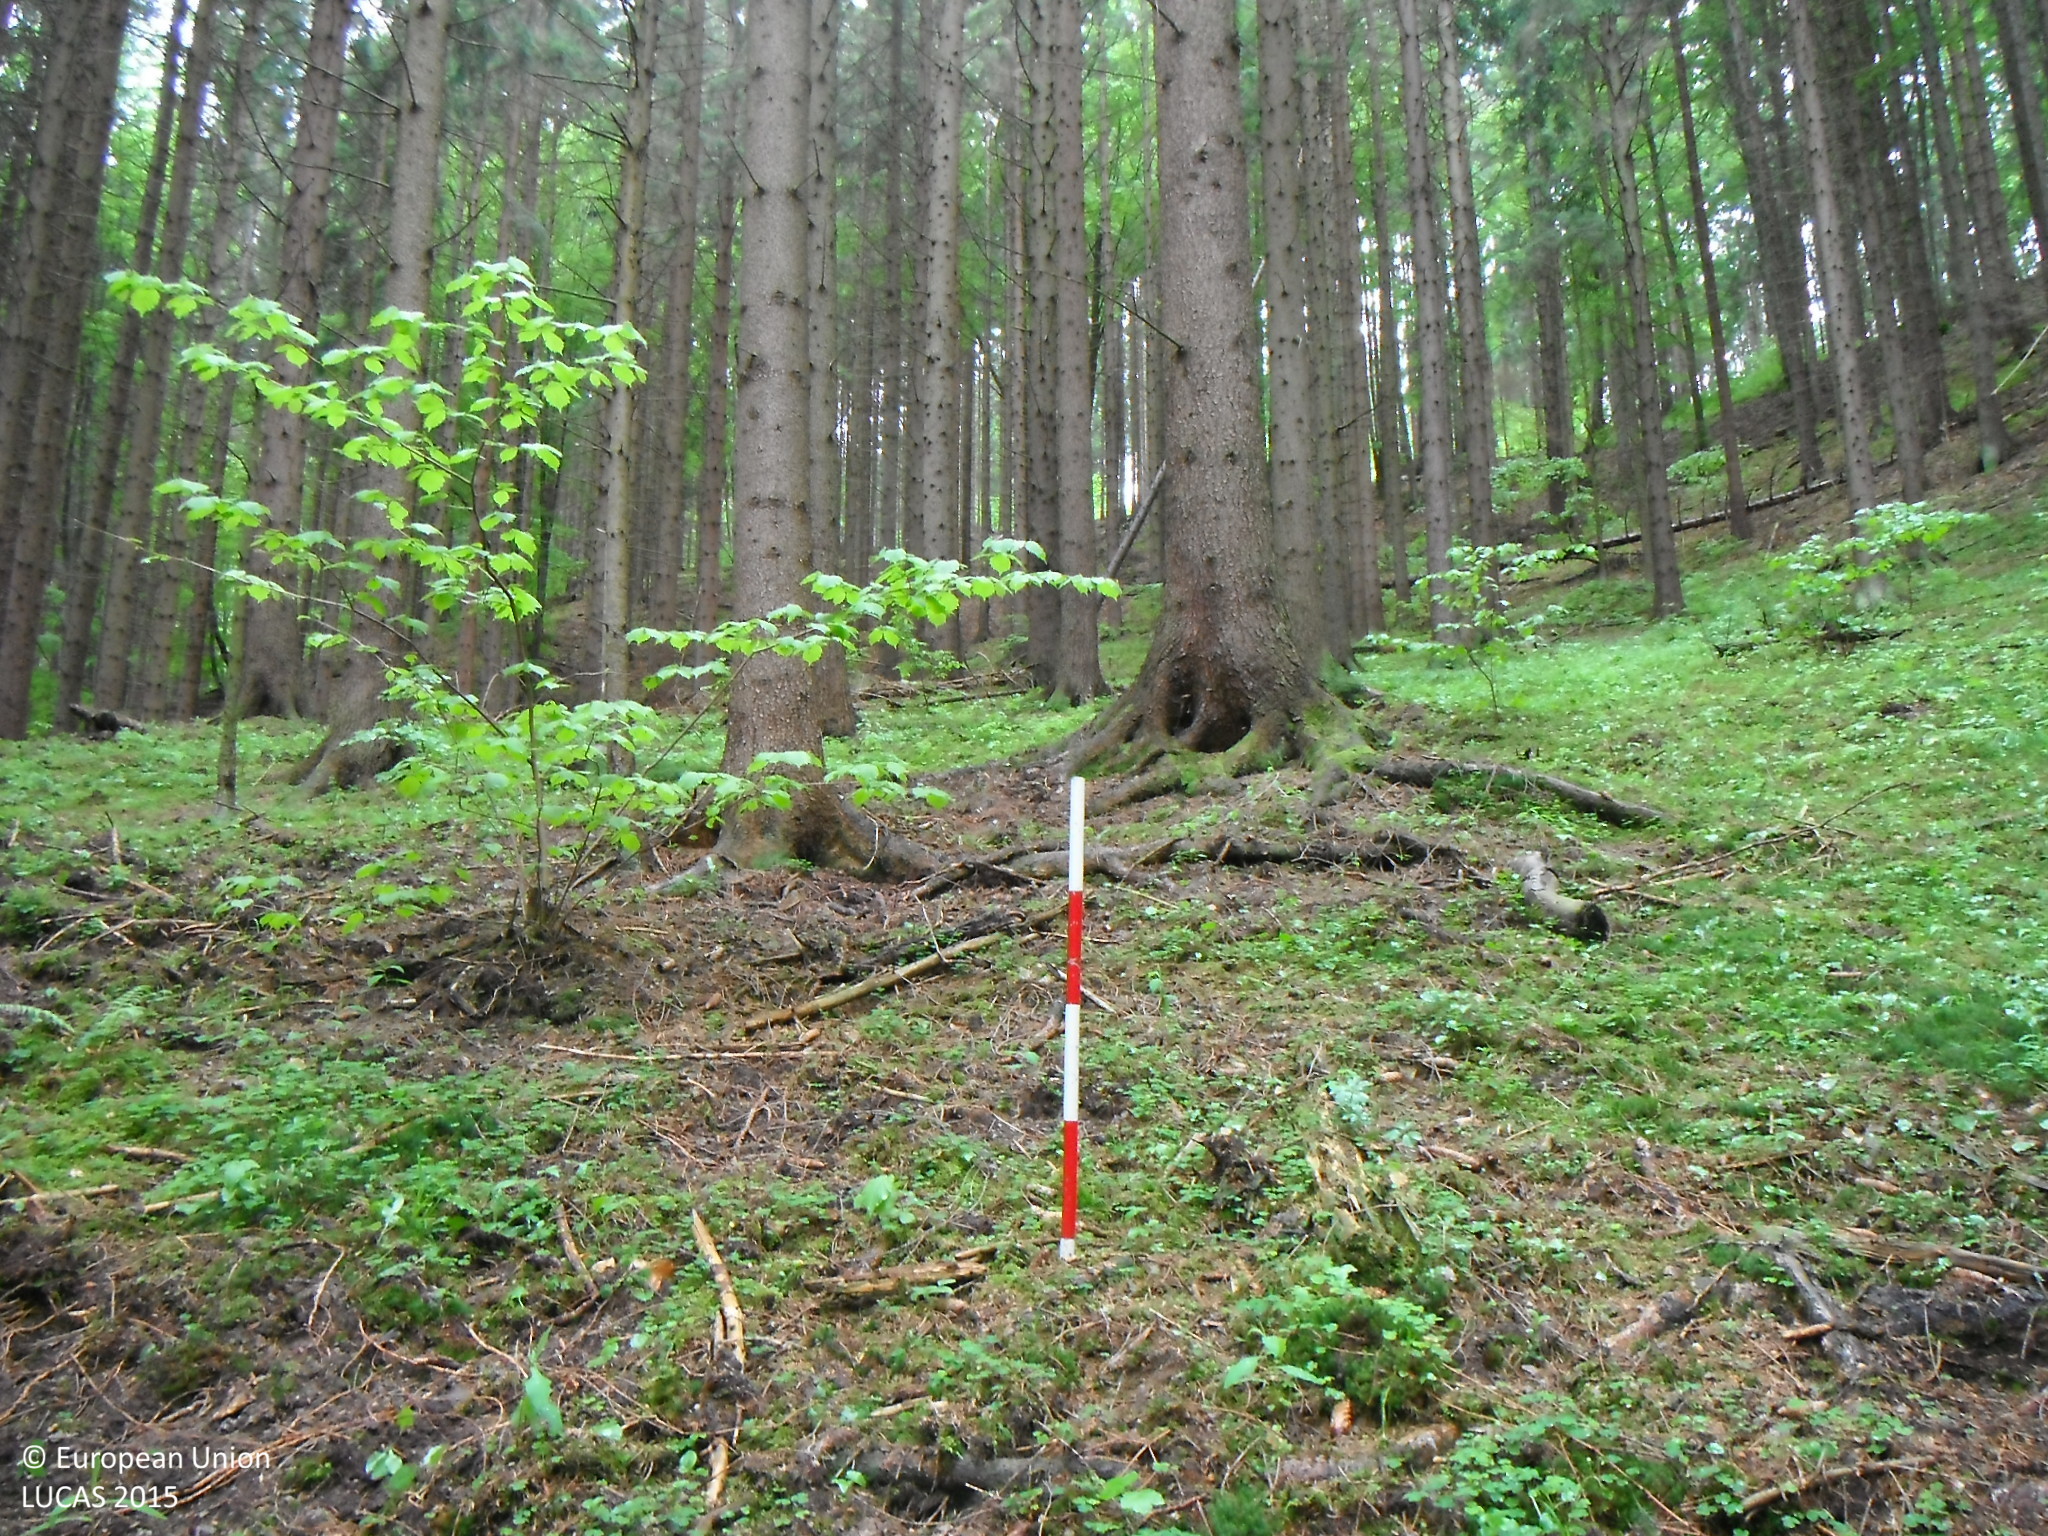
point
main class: Woodland
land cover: Spruce dominated coniferous woodland
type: alpine coniferous forest
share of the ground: > 75 %
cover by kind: coniferous forest trees 100 %
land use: Forestry
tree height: > 5 m
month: May
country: SK
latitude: 48.9929
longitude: 19.0283
